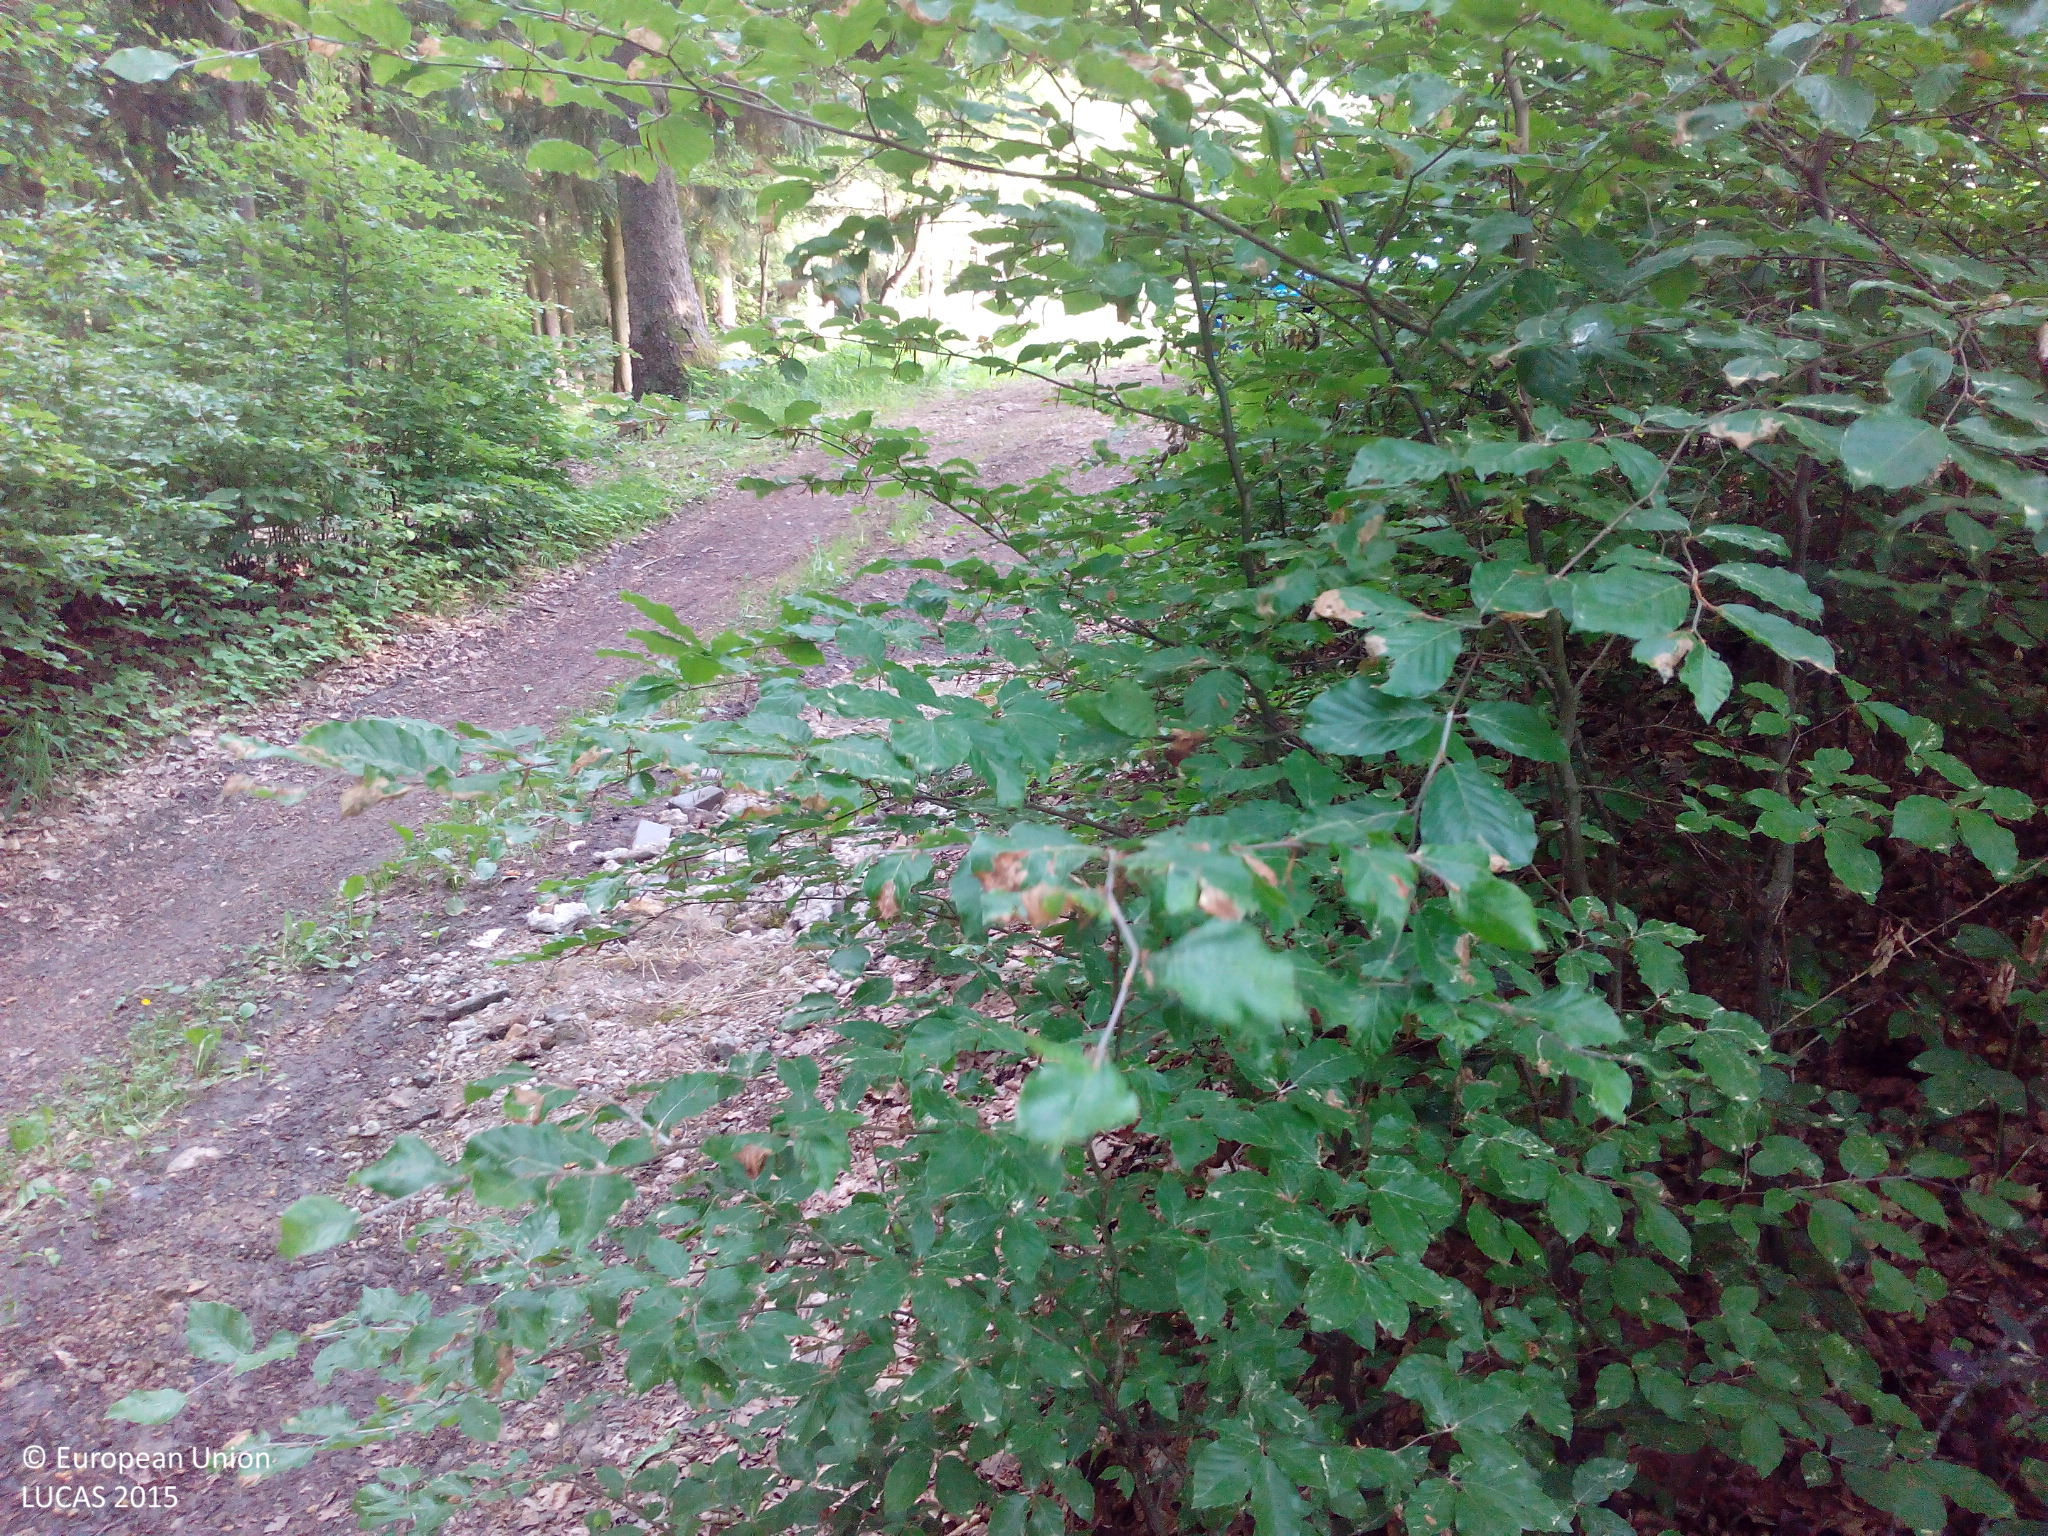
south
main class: Woodland
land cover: Spruce dominated mixed woodland
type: hemiboreal forest and nemoral coniferous forest and mixed broadleaved-coniferous forest
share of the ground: > 75 %
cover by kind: coniferous forest trees 50 %, broadleaved forest trees 30 %, unconsolidated bare surface 15 %, shrubs 5 %
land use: Forestry
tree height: > 5 m
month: May
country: DE
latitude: 49.1784
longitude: 11.9337
